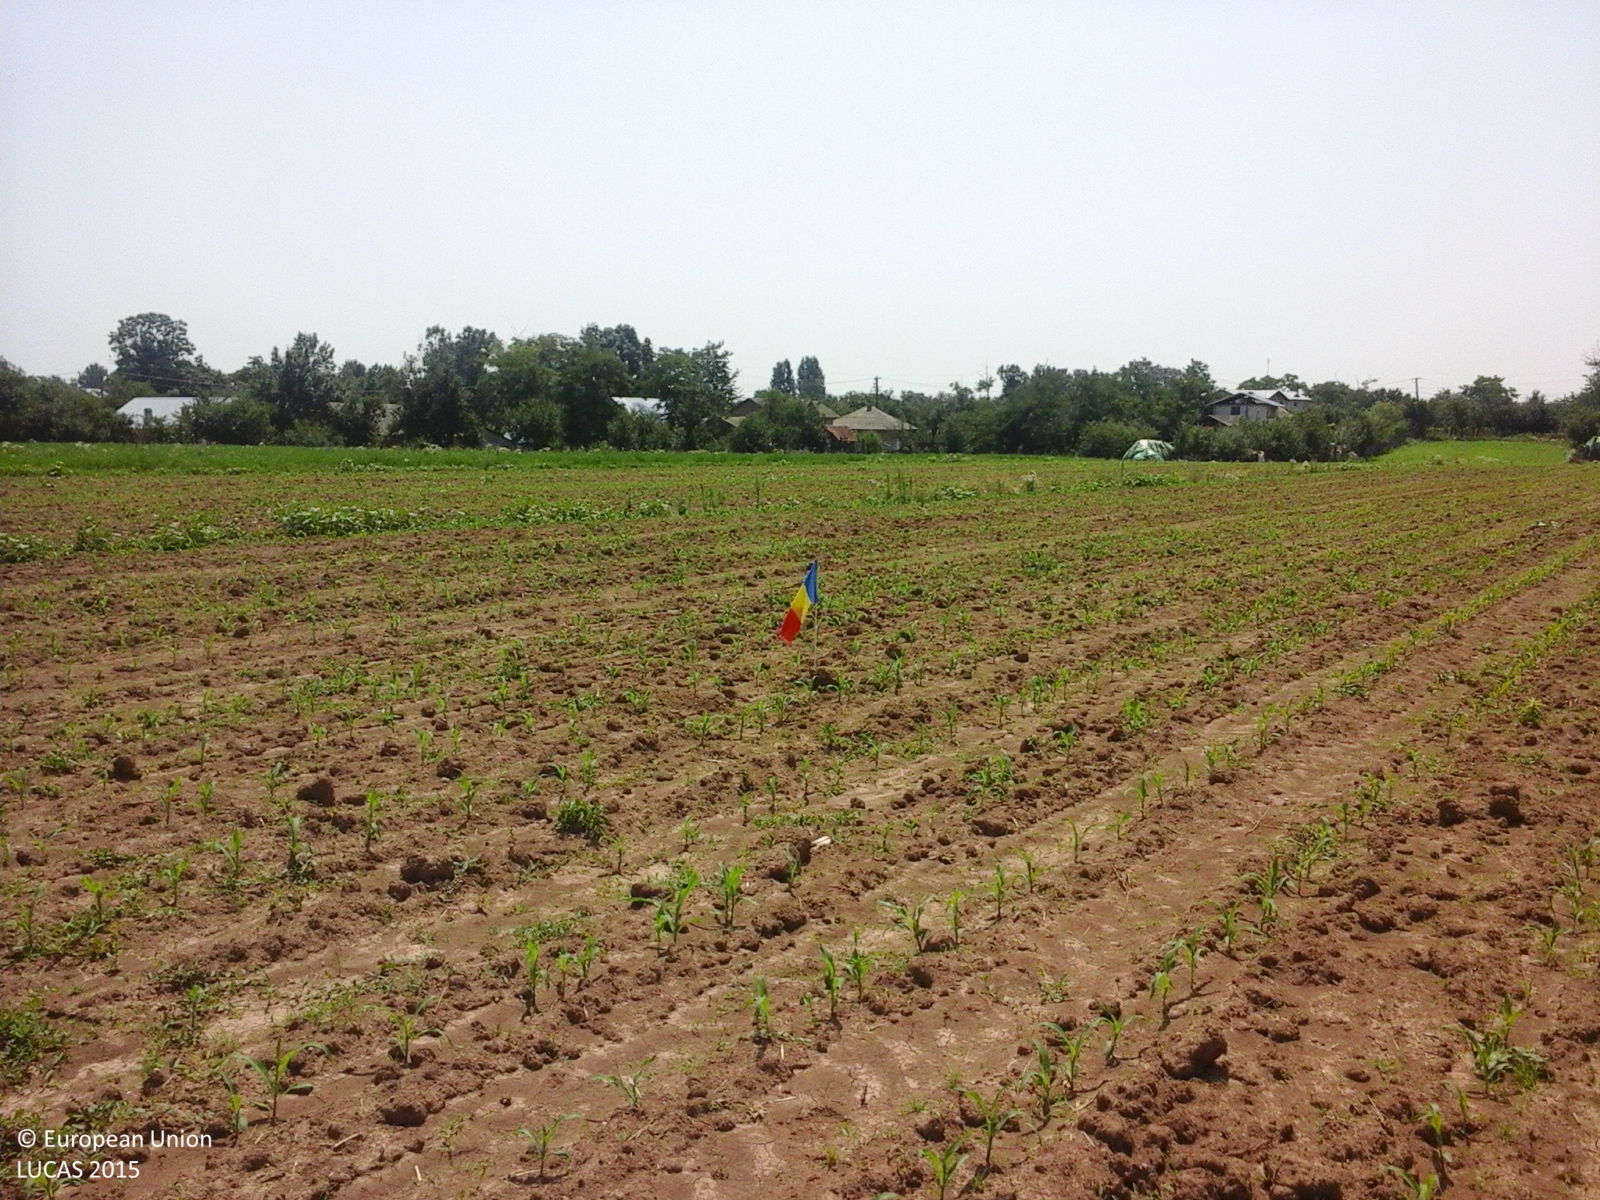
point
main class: Cropland
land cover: Maize
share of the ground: < 10 %
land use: Agriculture (excluding fallow land and kitchen gardens)
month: July
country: RO
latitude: 44.5518
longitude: 25.3843
